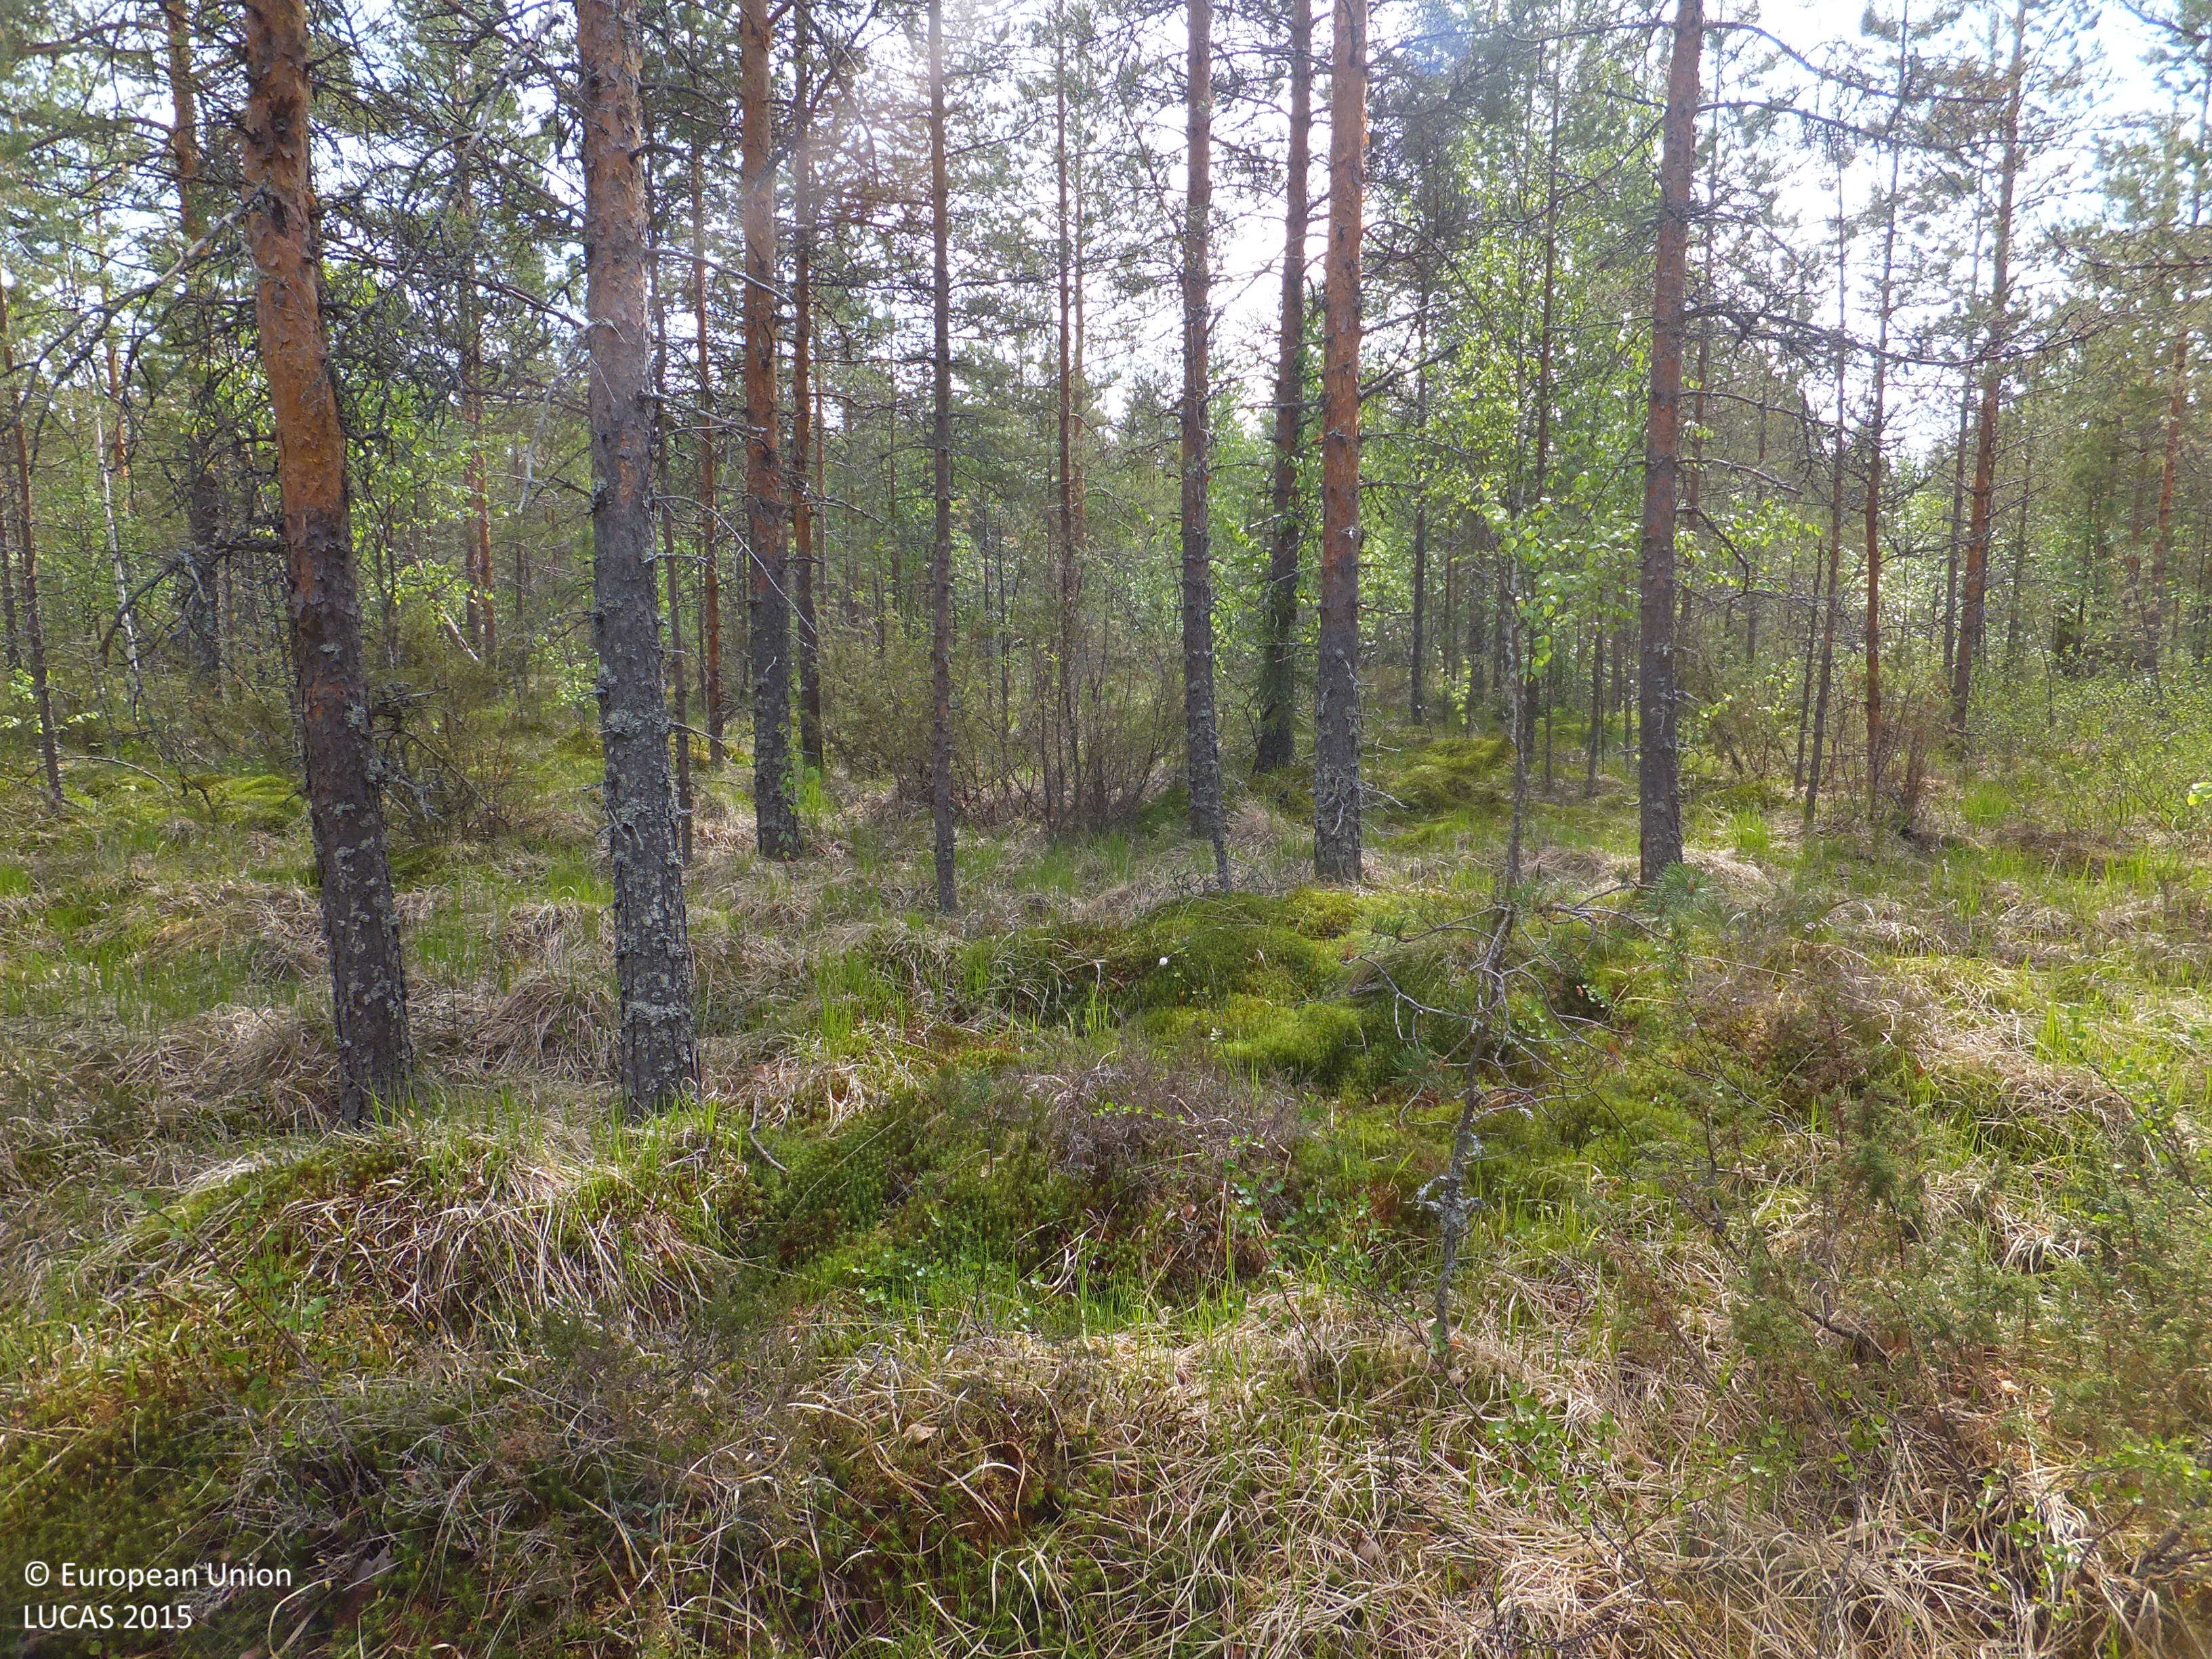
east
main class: Woodland
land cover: Pine dominated mixed woodland
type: boreal forest
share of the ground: 50 - 75 %
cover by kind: coniferous forest trees 30 %, broadleaved forest trees 30 %, herbaceous plants 15 %, lichens and mosses 15 %, shrubs 10 %
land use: Forestry
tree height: > 5 m
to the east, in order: Pine dominated mixed woodland; Ditches and canals; Pine dominated mixed woodland; Ditches and canals; Pine dominated mixed woodland; Ditches and canals; Pine dominated mixed woodland; Ditches and canals; Pine dominated mixed woodland
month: June
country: FI
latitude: 63.5906
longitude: 24.7751
